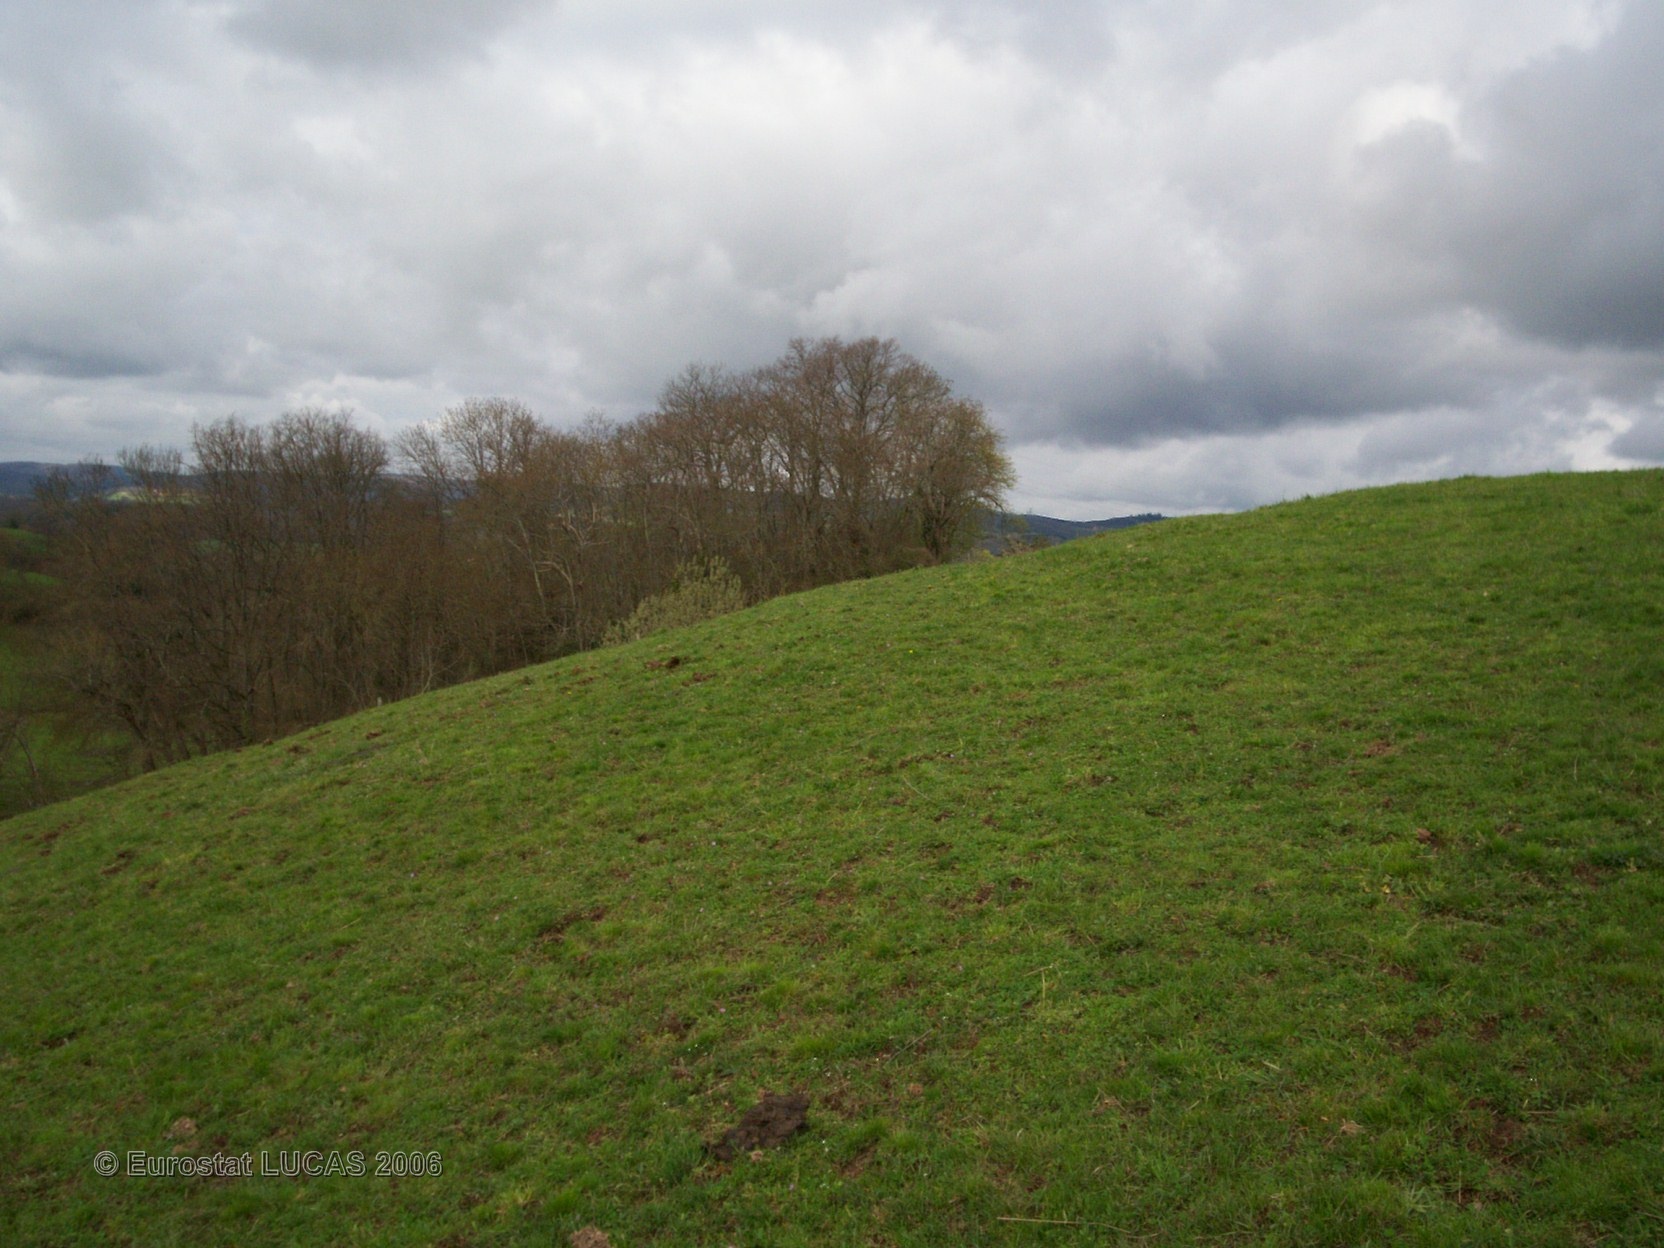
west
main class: Grassland
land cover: Grassland without tree/shrub cover
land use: Agriculture (excluding fallow land and kitchen gardens)
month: April
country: FR
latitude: 46.4174
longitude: 4.6805
